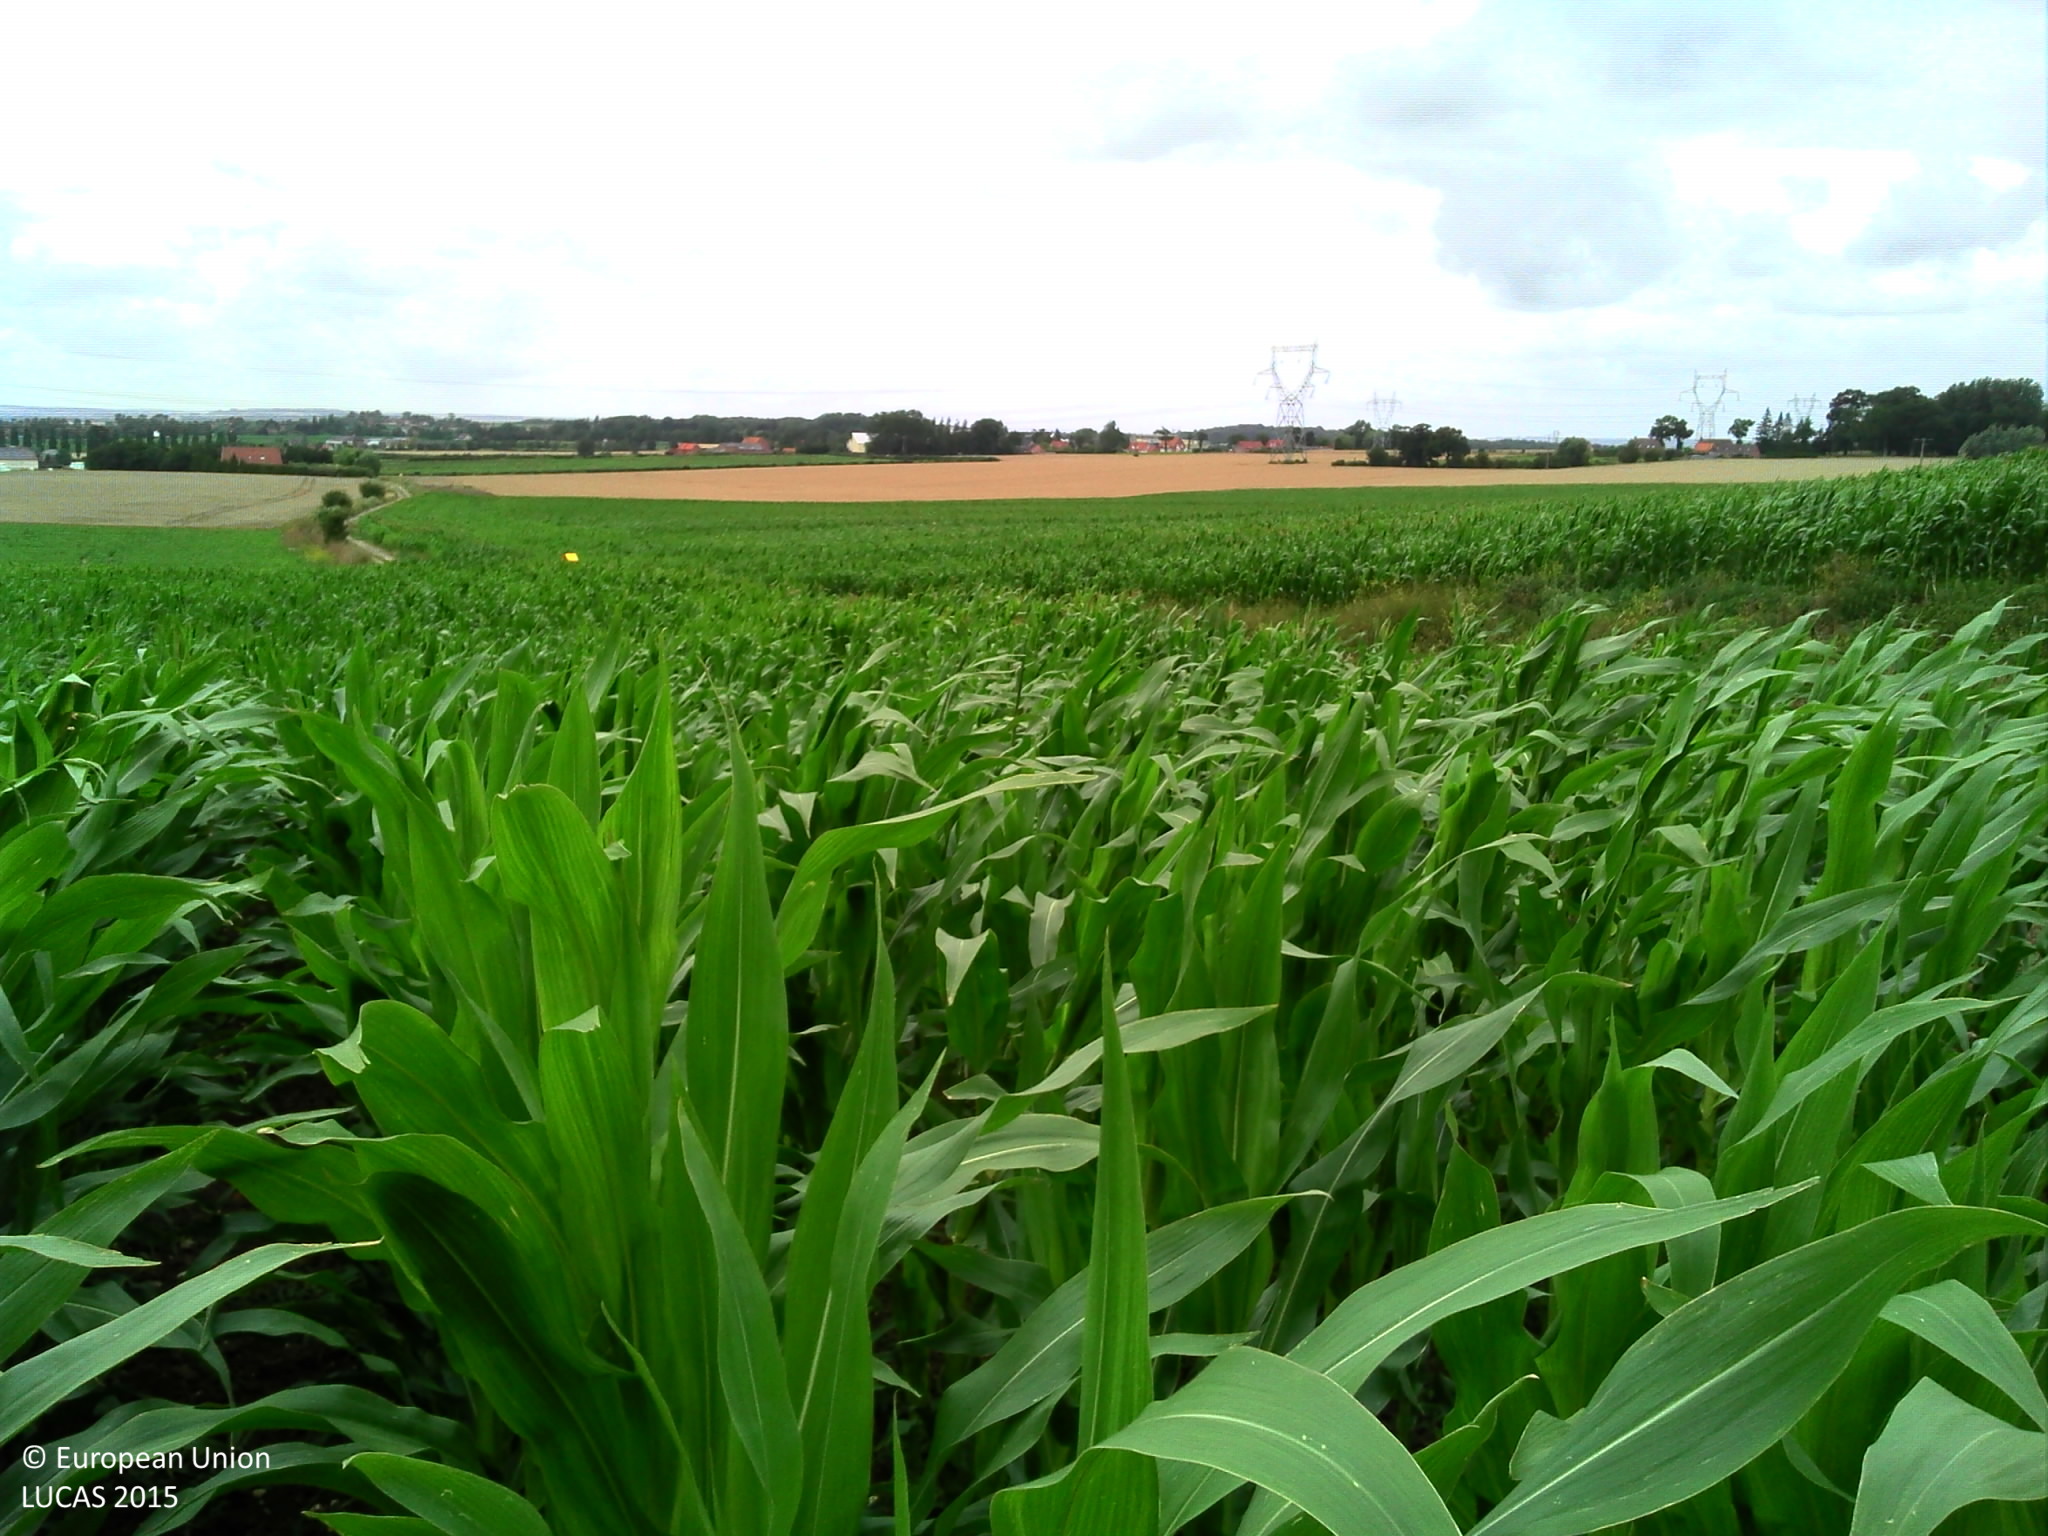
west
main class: Cropland
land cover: Maize
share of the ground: > 75 %
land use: Agriculture (excluding fallow land and kitchen gardens)
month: July
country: FR
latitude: 50.7435
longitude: 2.4049
